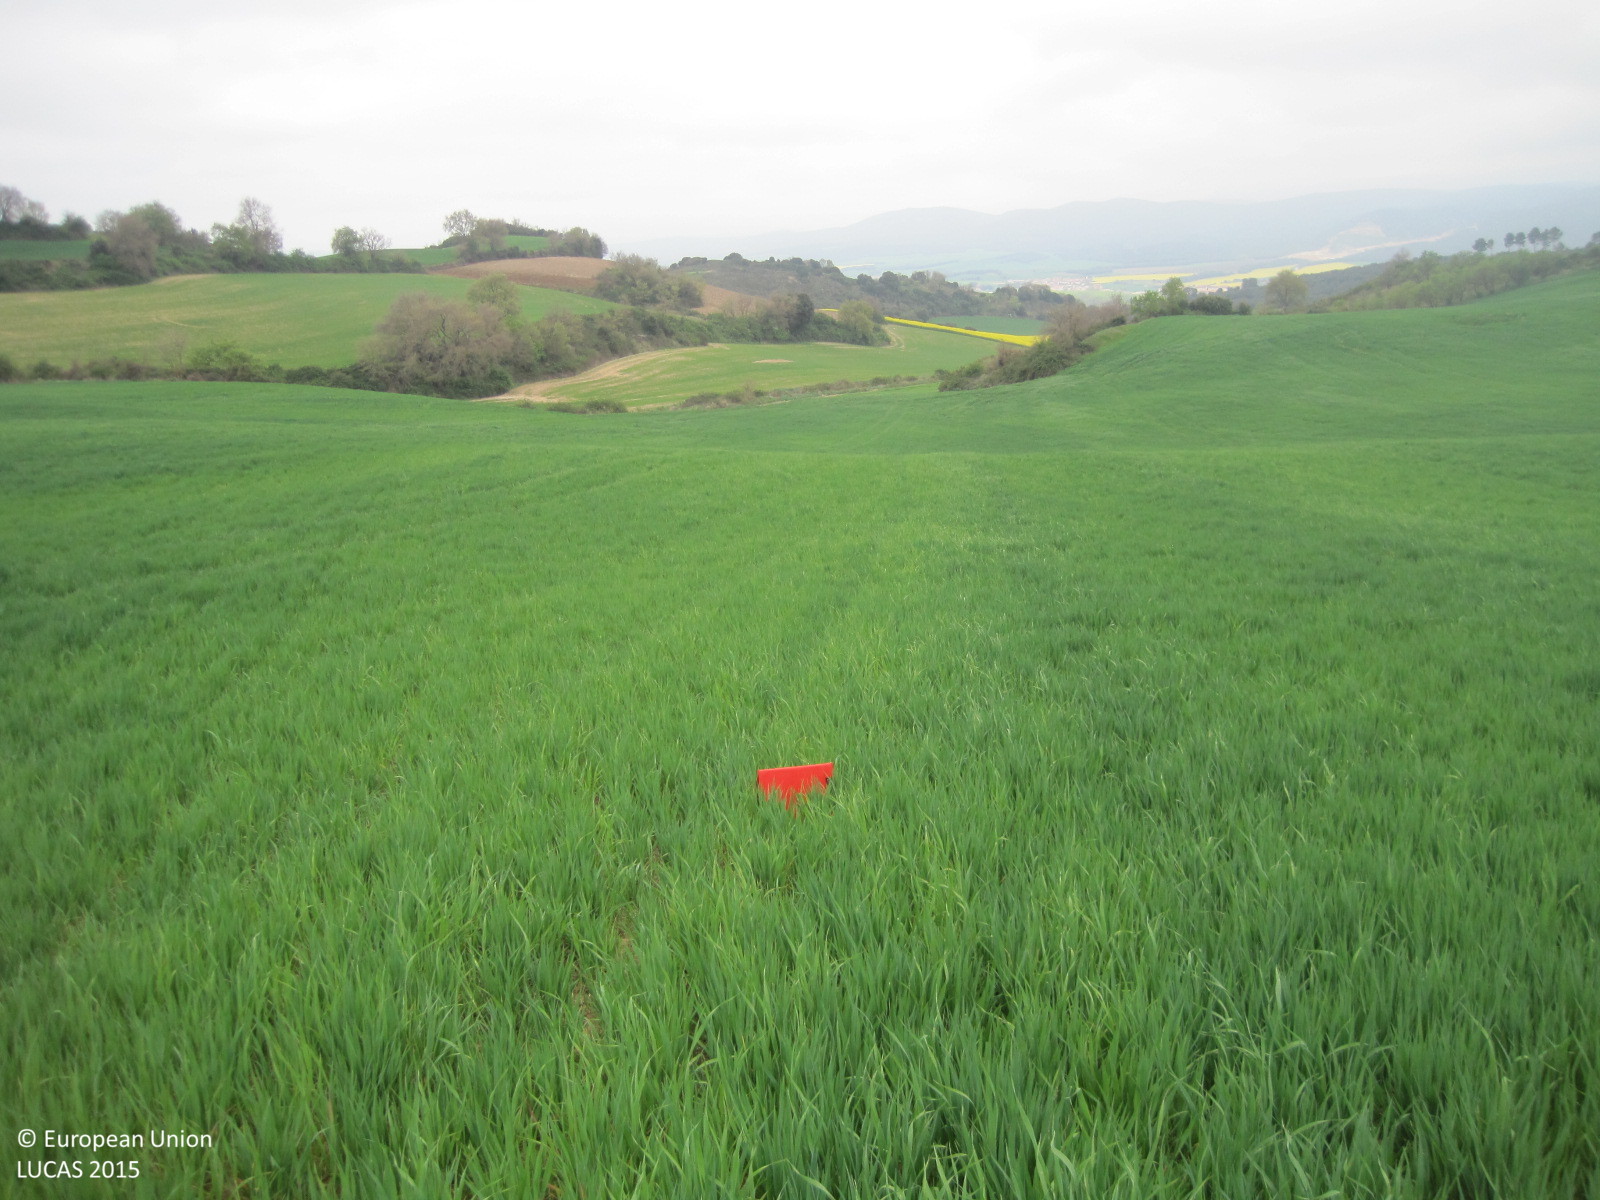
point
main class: Cropland
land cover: Rye
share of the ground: > 75 %
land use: Agriculture (excluding fallow land and kitchen gardens)
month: April
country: ES
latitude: 42.6338
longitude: -2.1275
